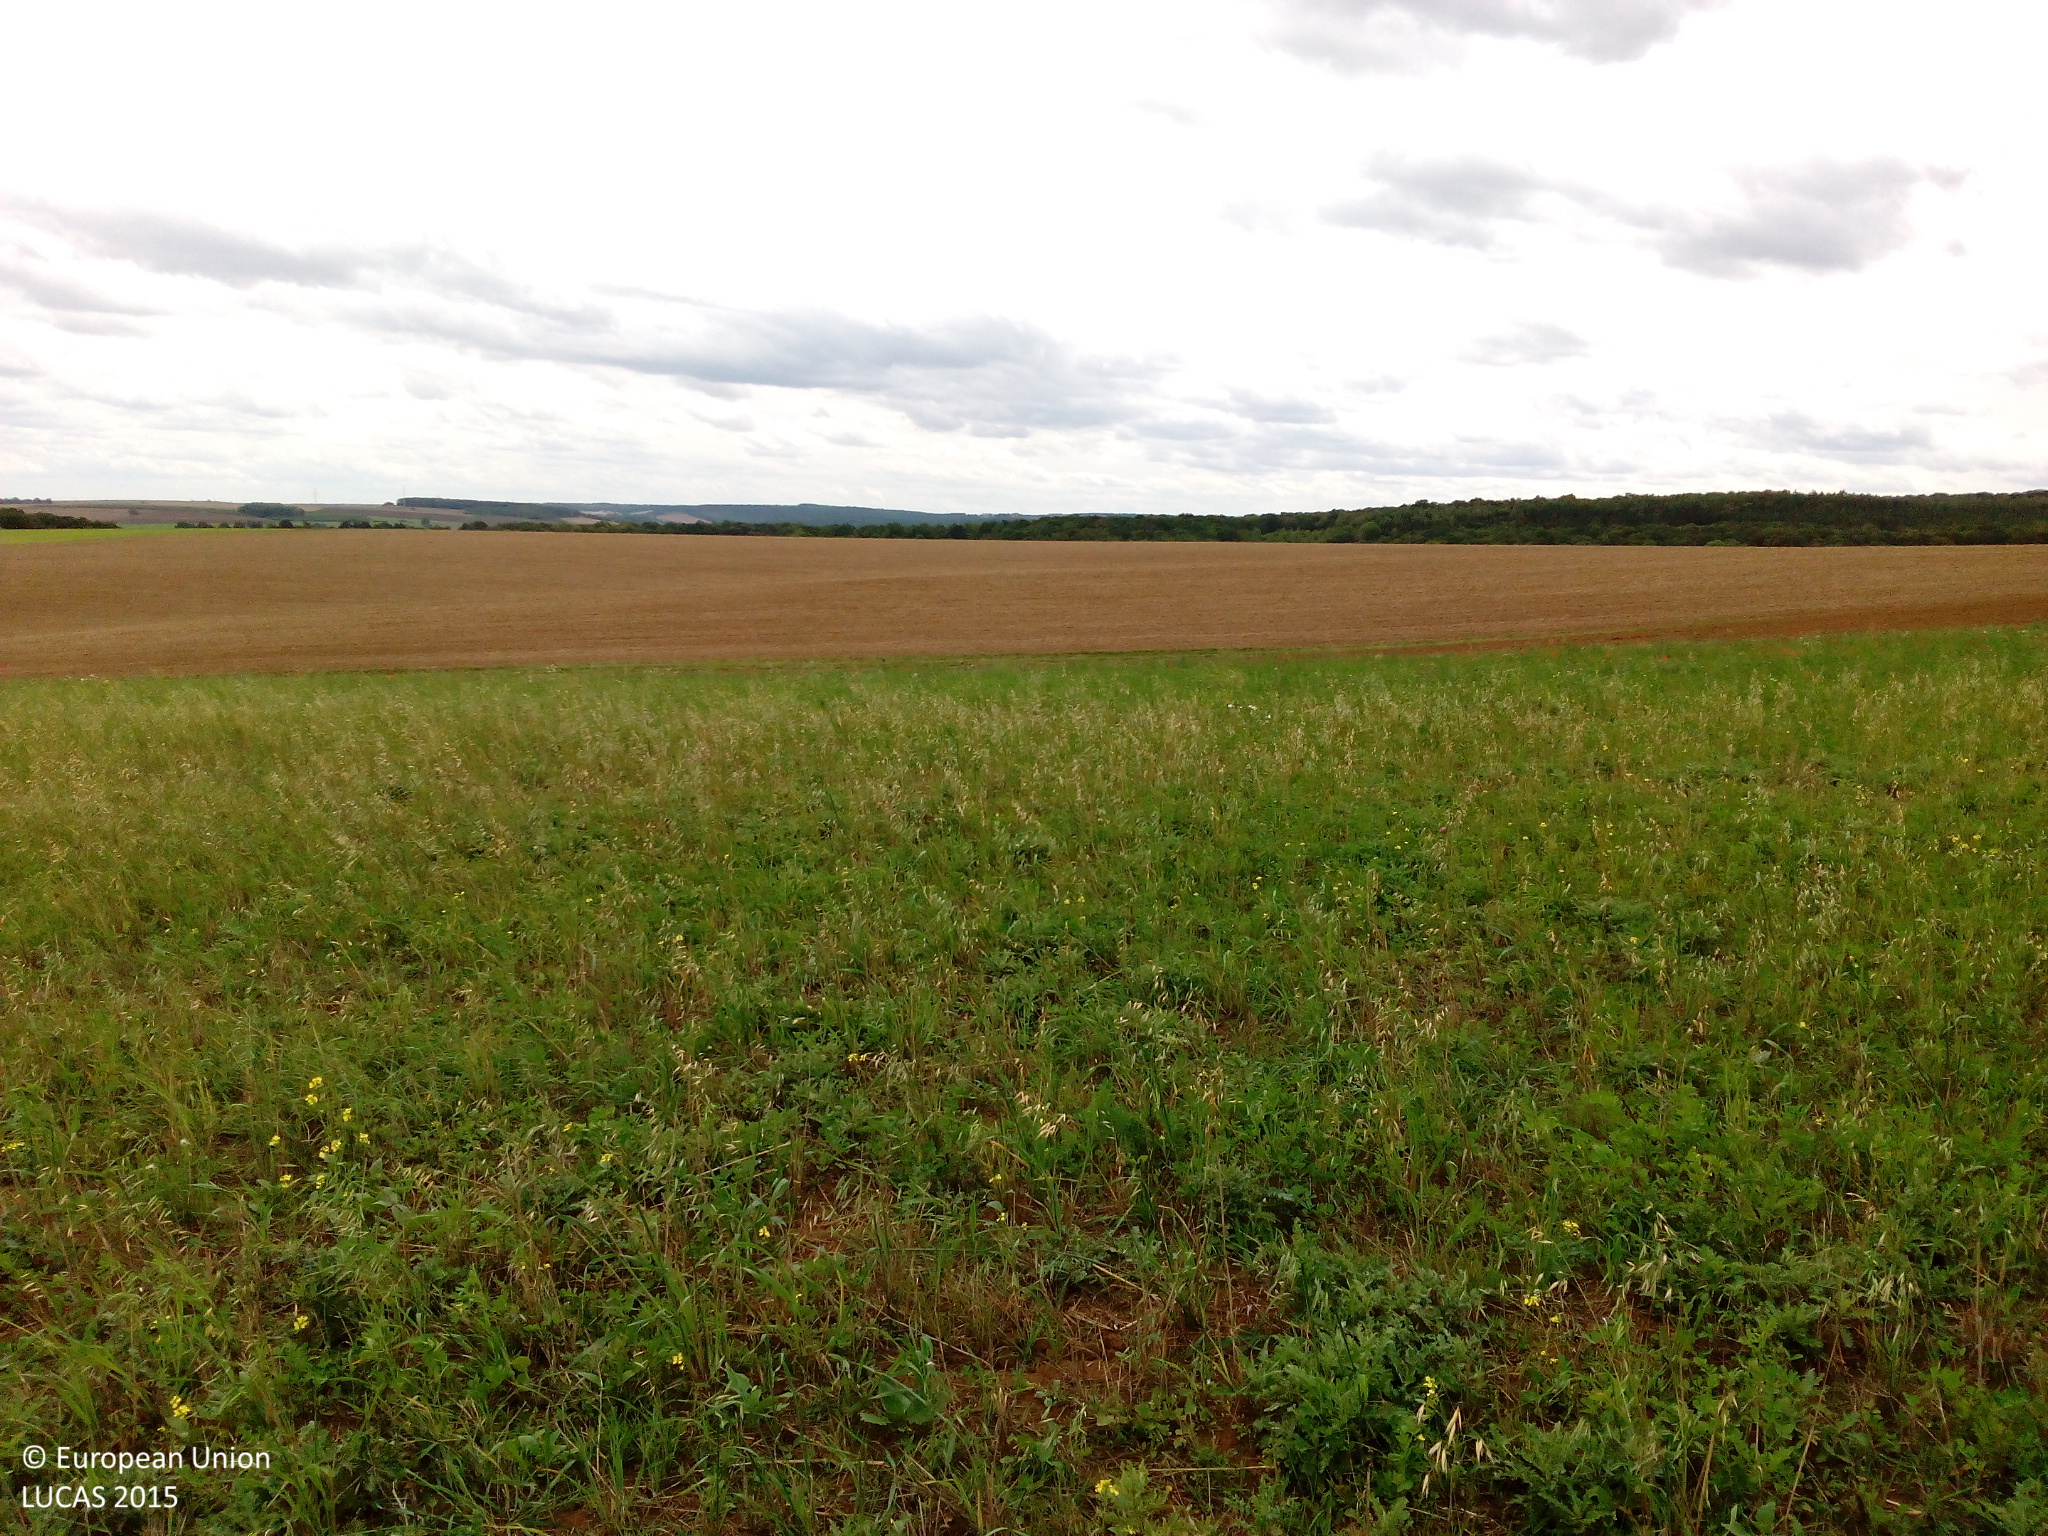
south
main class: Cropland
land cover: Other leguminous and mixtures for fodder
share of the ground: 50 - 75 %
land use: Agriculture (excluding fallow land and kitchen gardens)
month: September
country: DE
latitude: 50.0224
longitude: 9.9302
